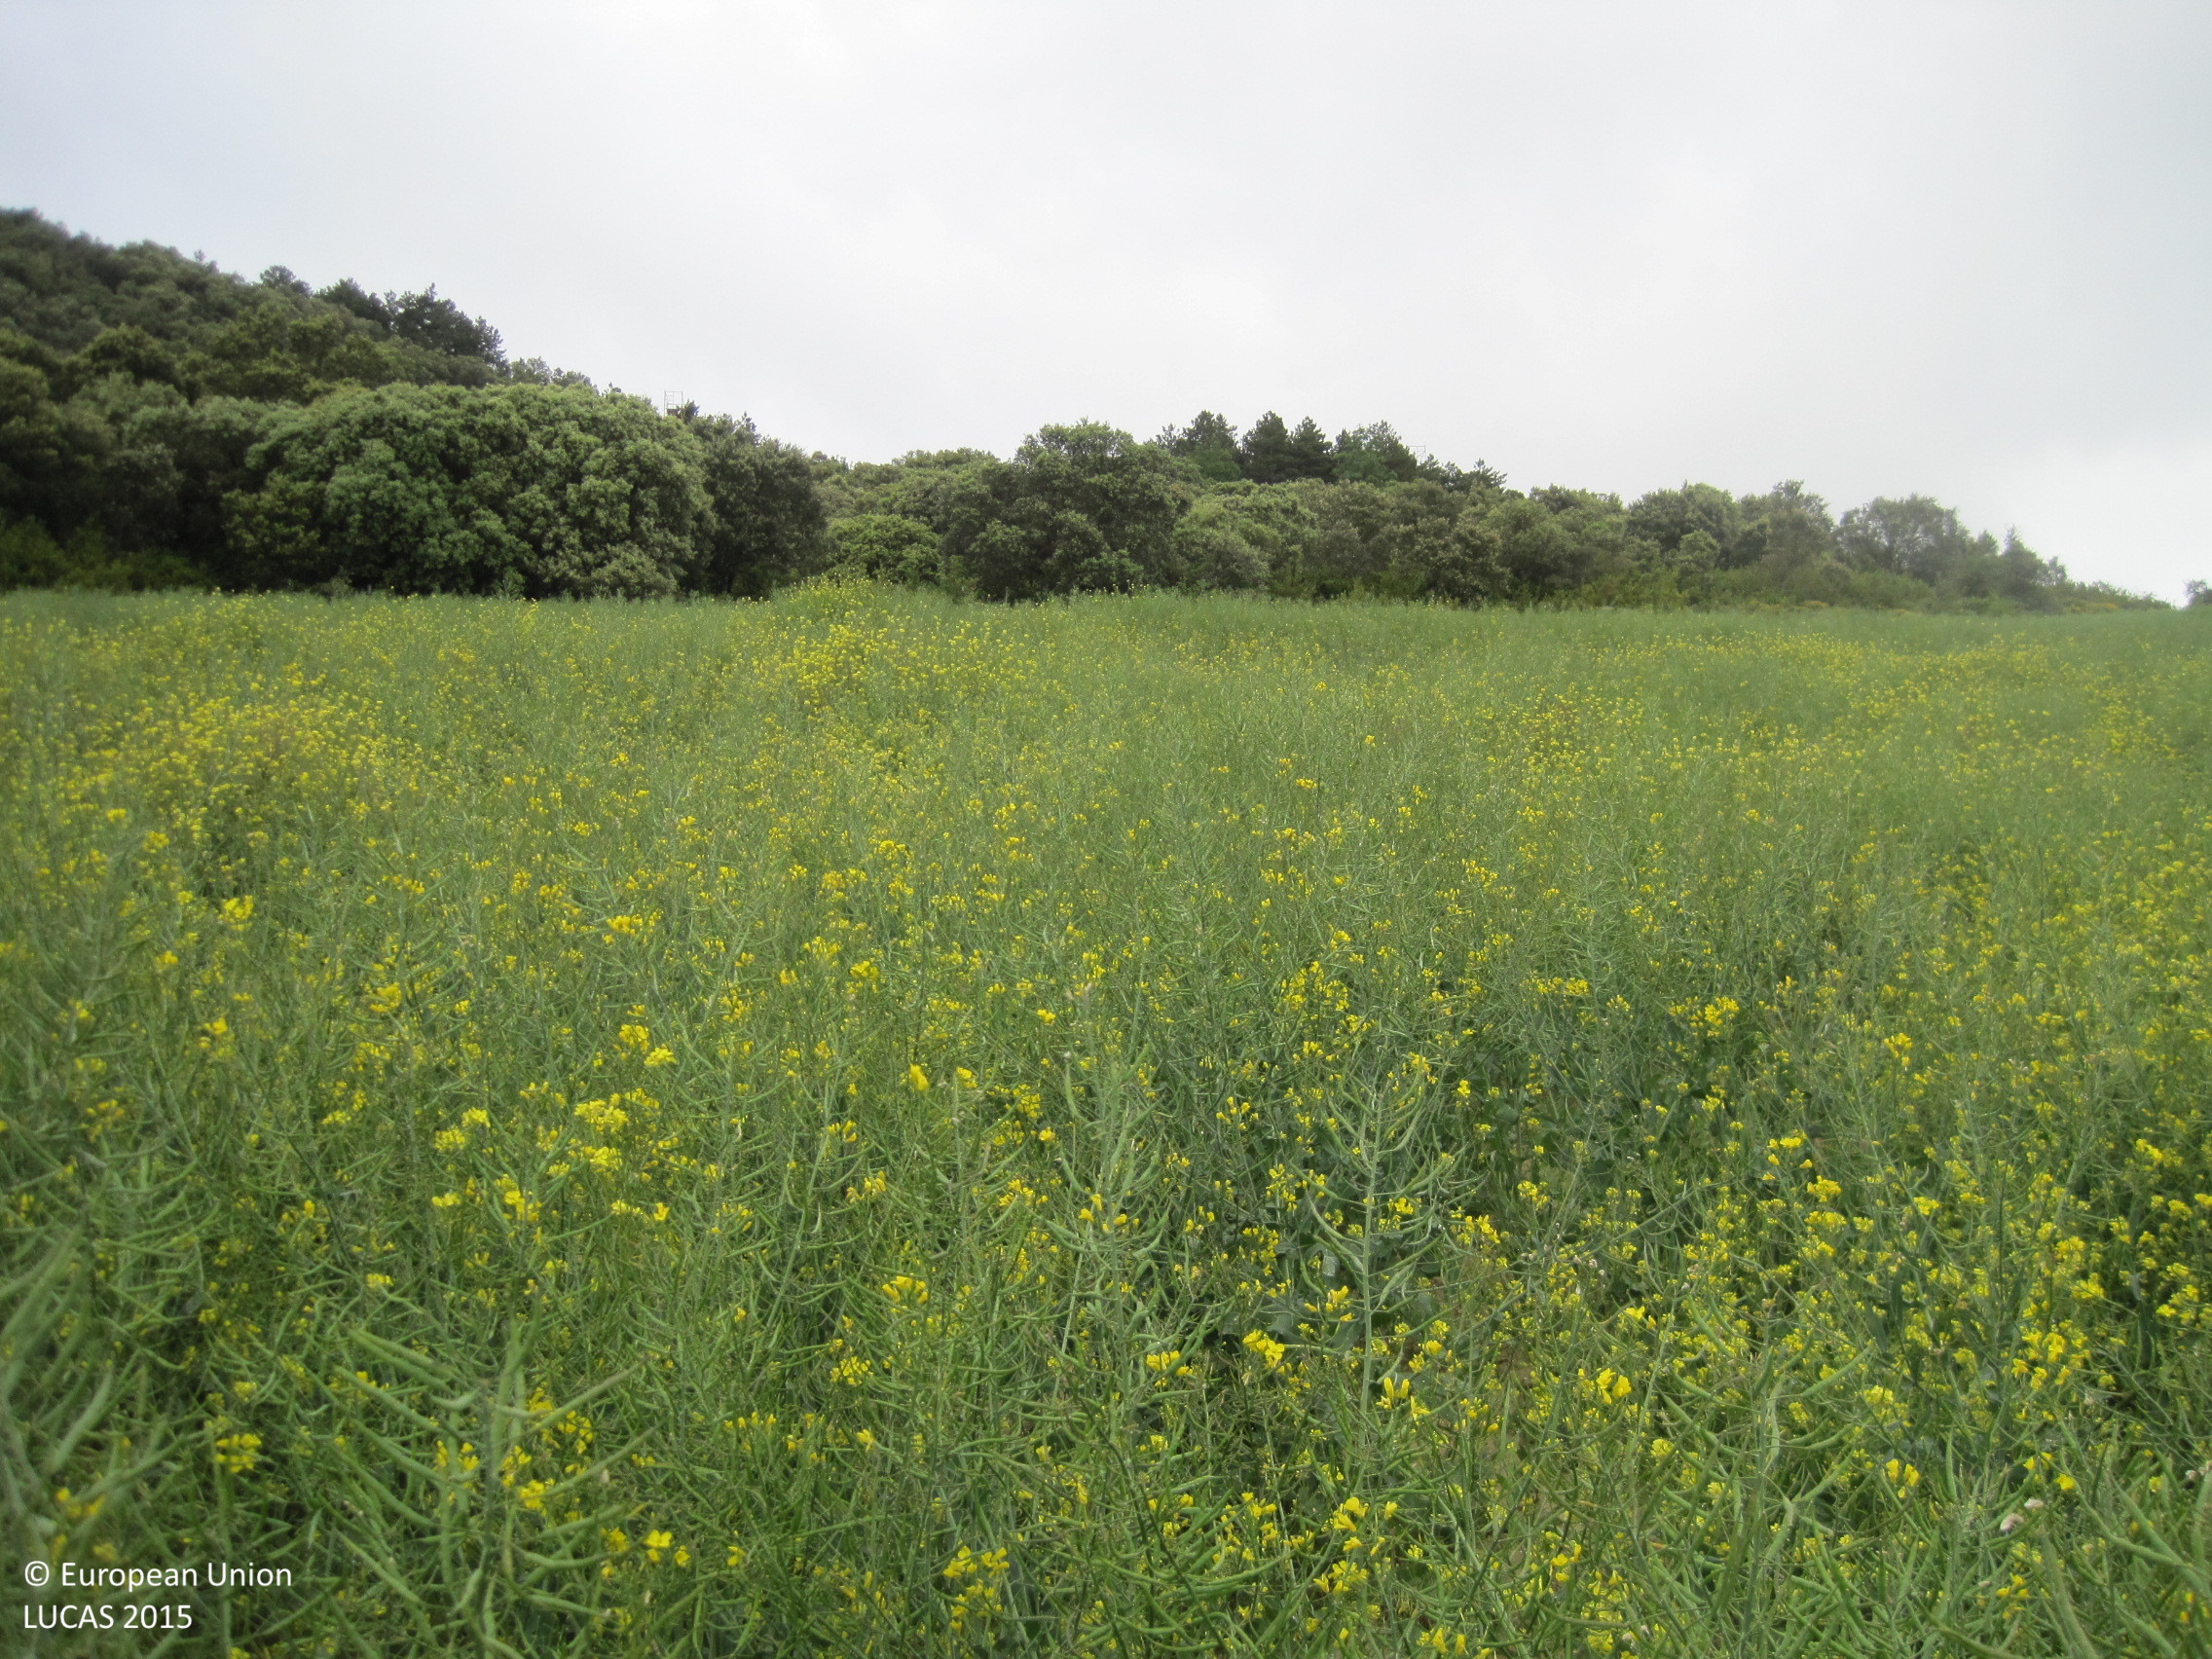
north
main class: Cropland
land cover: Rape and turnip rape
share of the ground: > 75 %
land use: Agriculture (excluding fallow land and kitchen gardens)
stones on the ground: < 10 %
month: May
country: ES
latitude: 42.7235
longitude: -1.6768
